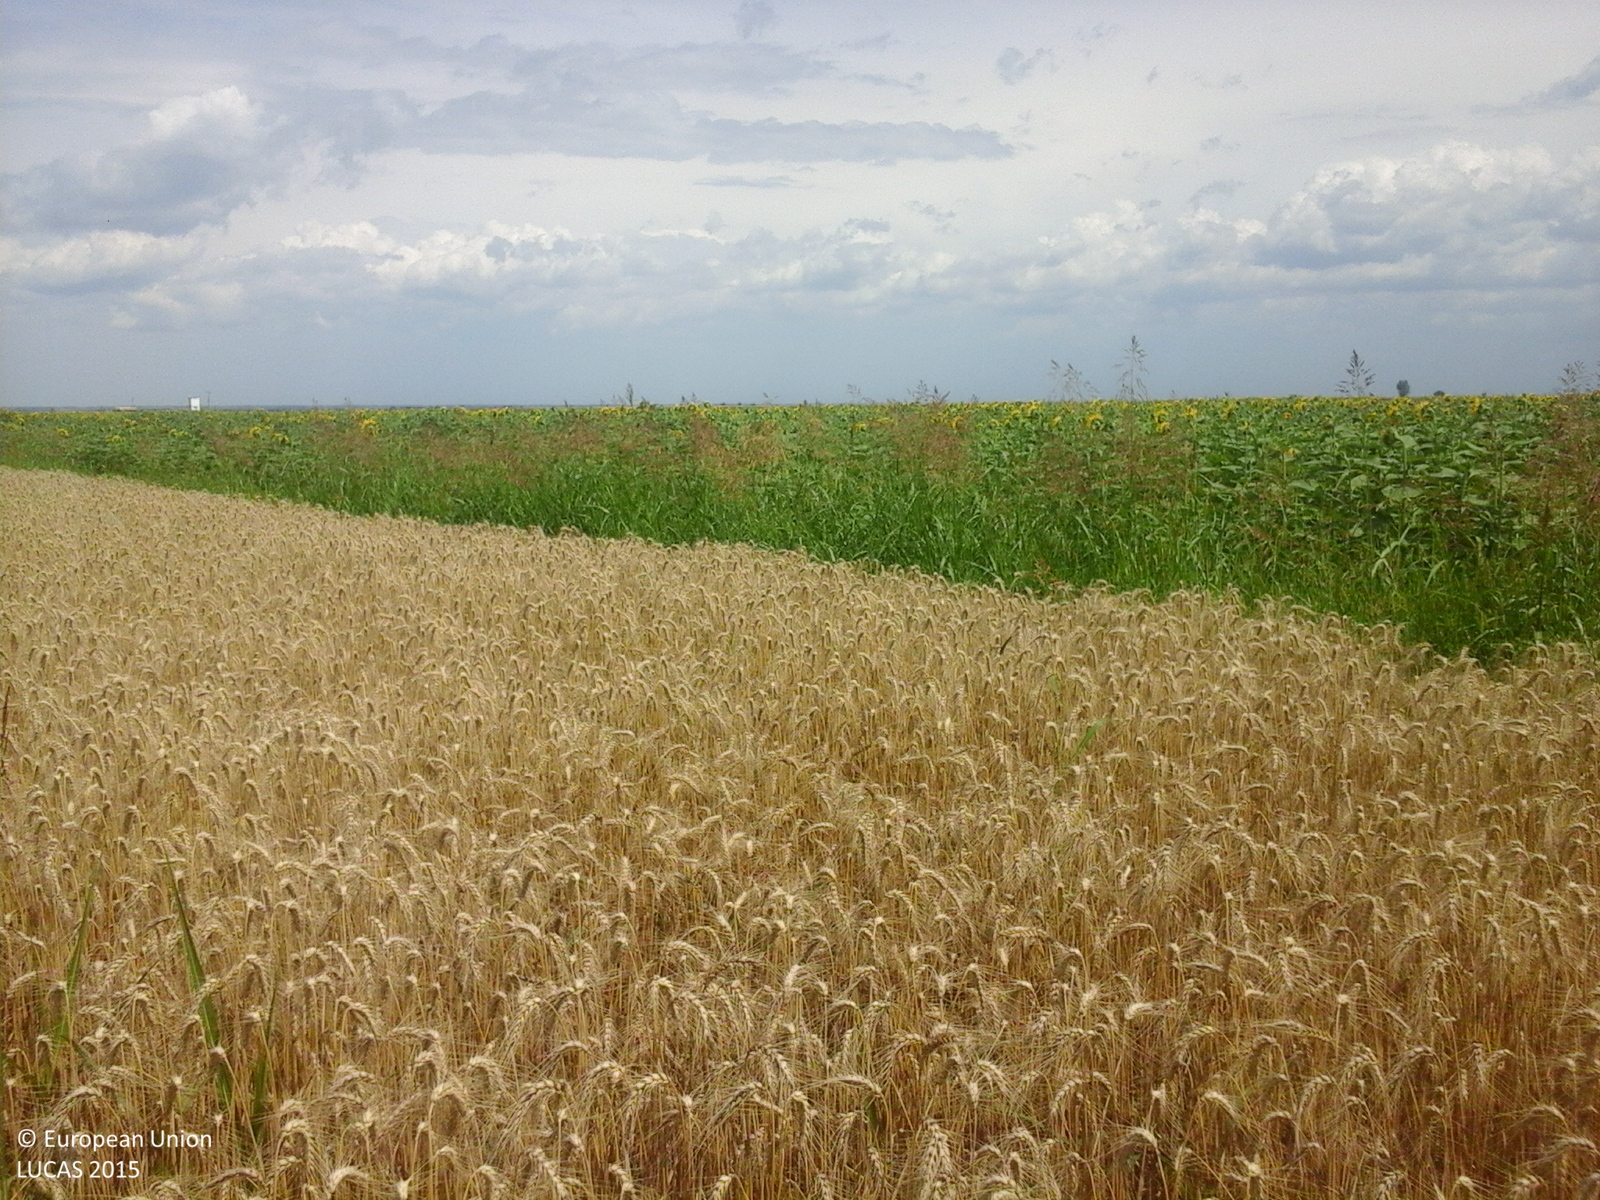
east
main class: Cropland
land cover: Common wheat
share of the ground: > 75 %
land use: Agriculture (excluding fallow land and kitchen gardens)
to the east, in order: Common wheat; Grass margins; Sunflower; Rye; Common wheat
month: July
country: RO
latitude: 44.0388
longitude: 24.5052
